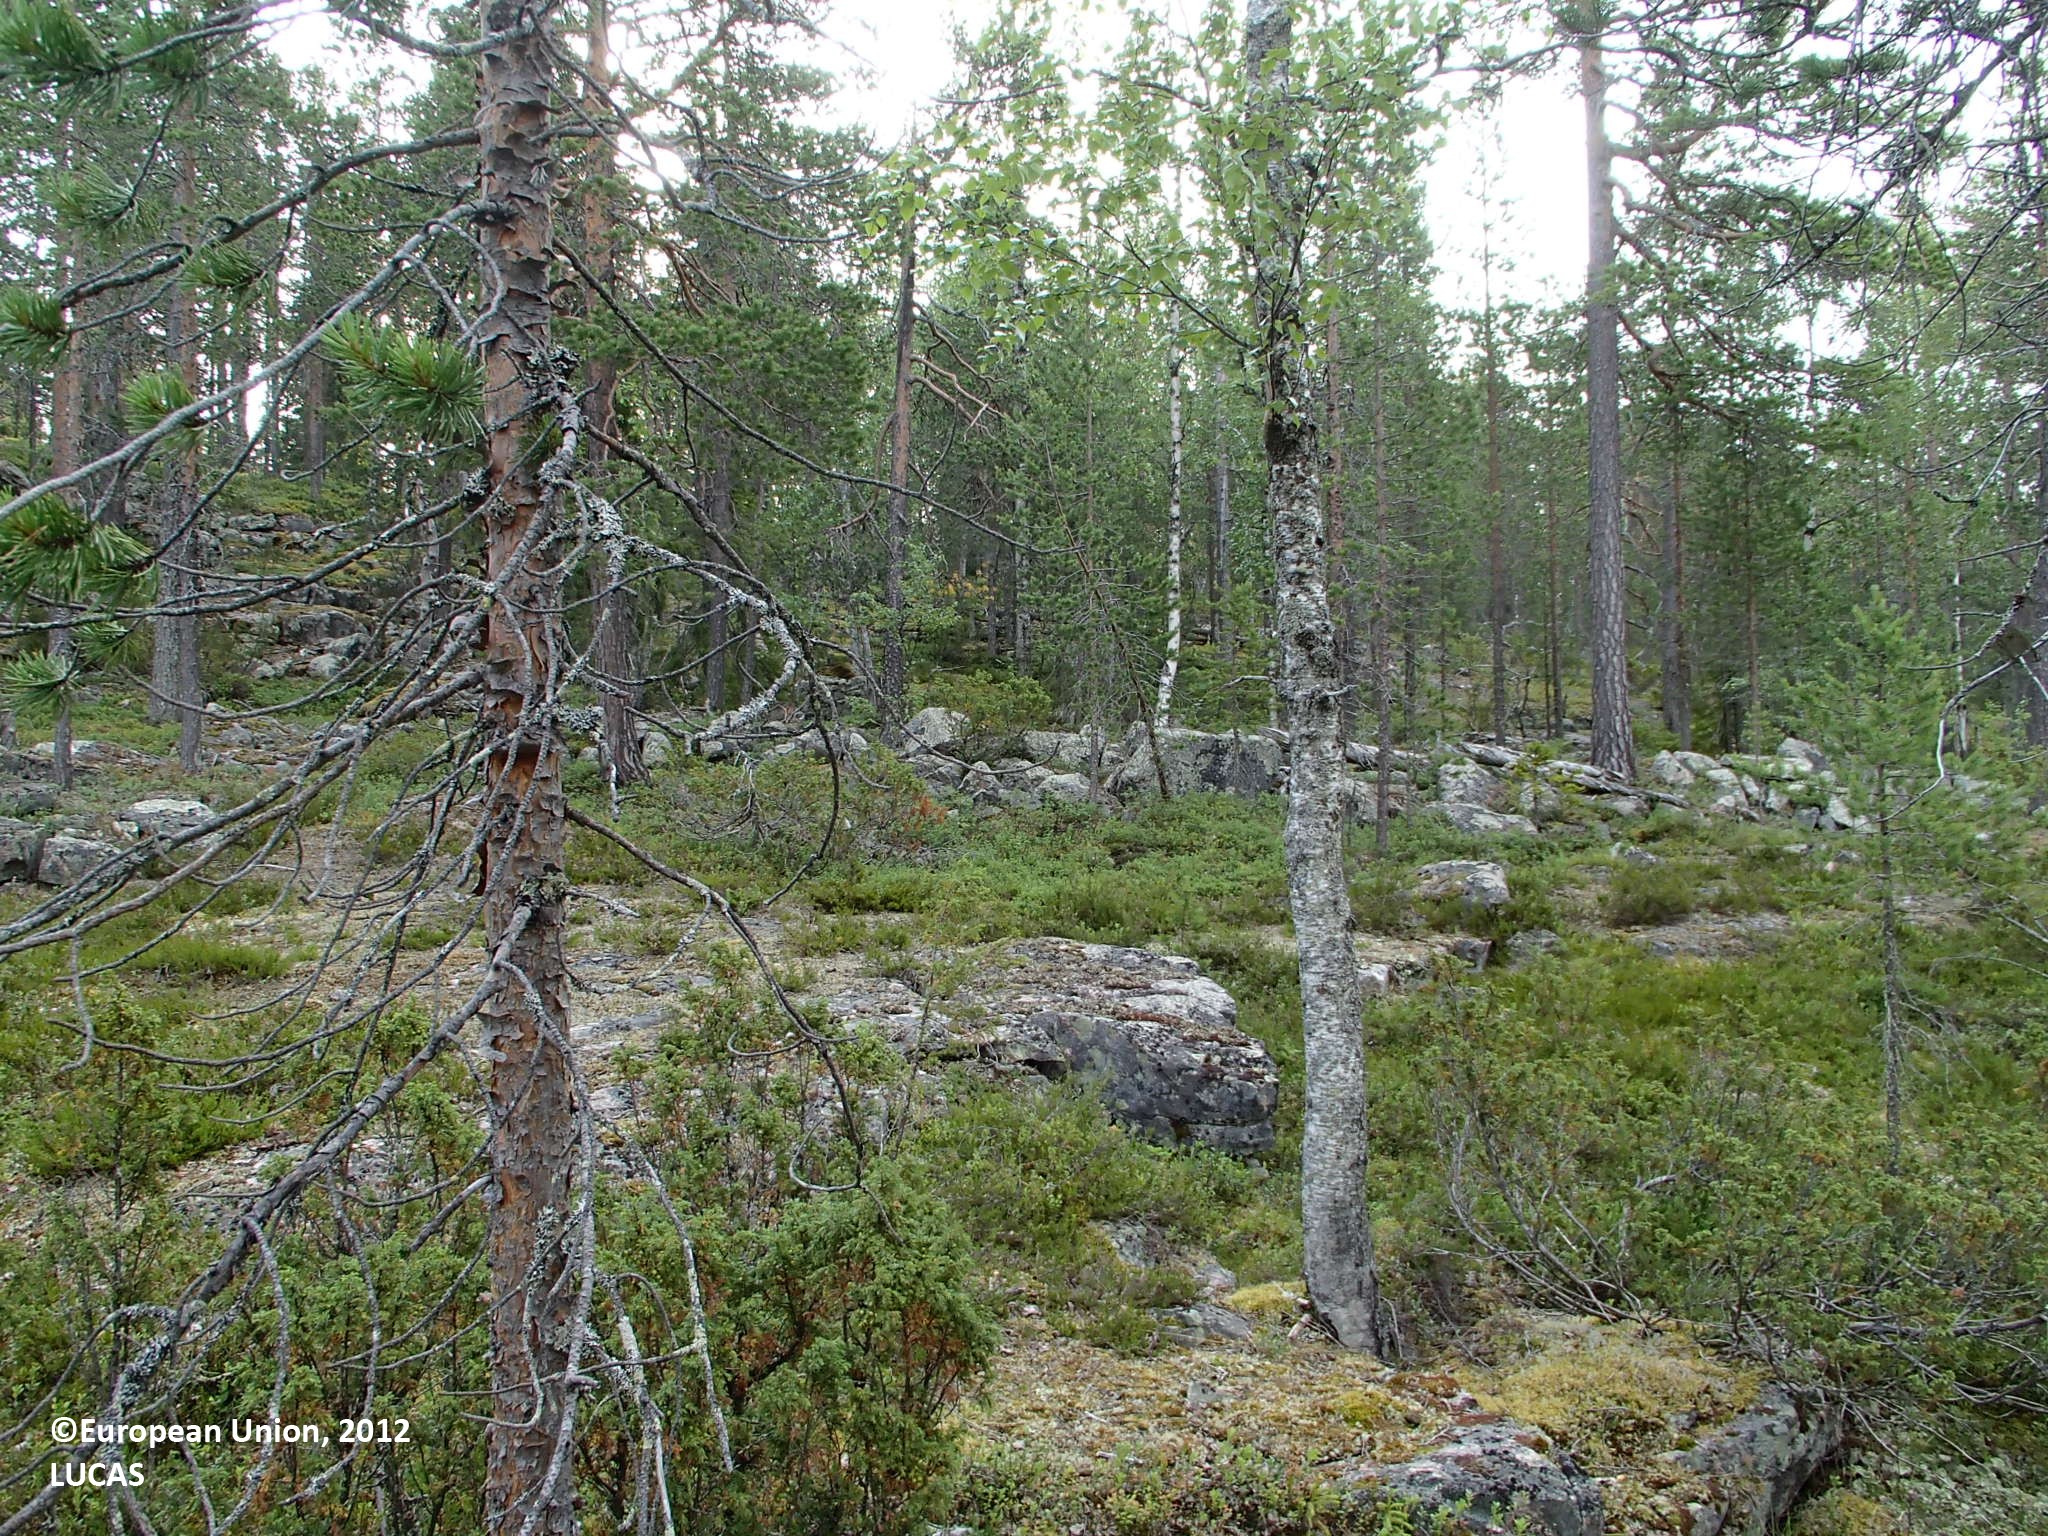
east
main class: Woodland
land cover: Other mixed woodland
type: boreal forest
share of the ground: 25 - 50 %
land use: Forestry
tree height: > 5 m
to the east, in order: Other mixed woodland
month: July
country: FI
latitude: 66.6217
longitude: 25.5792
